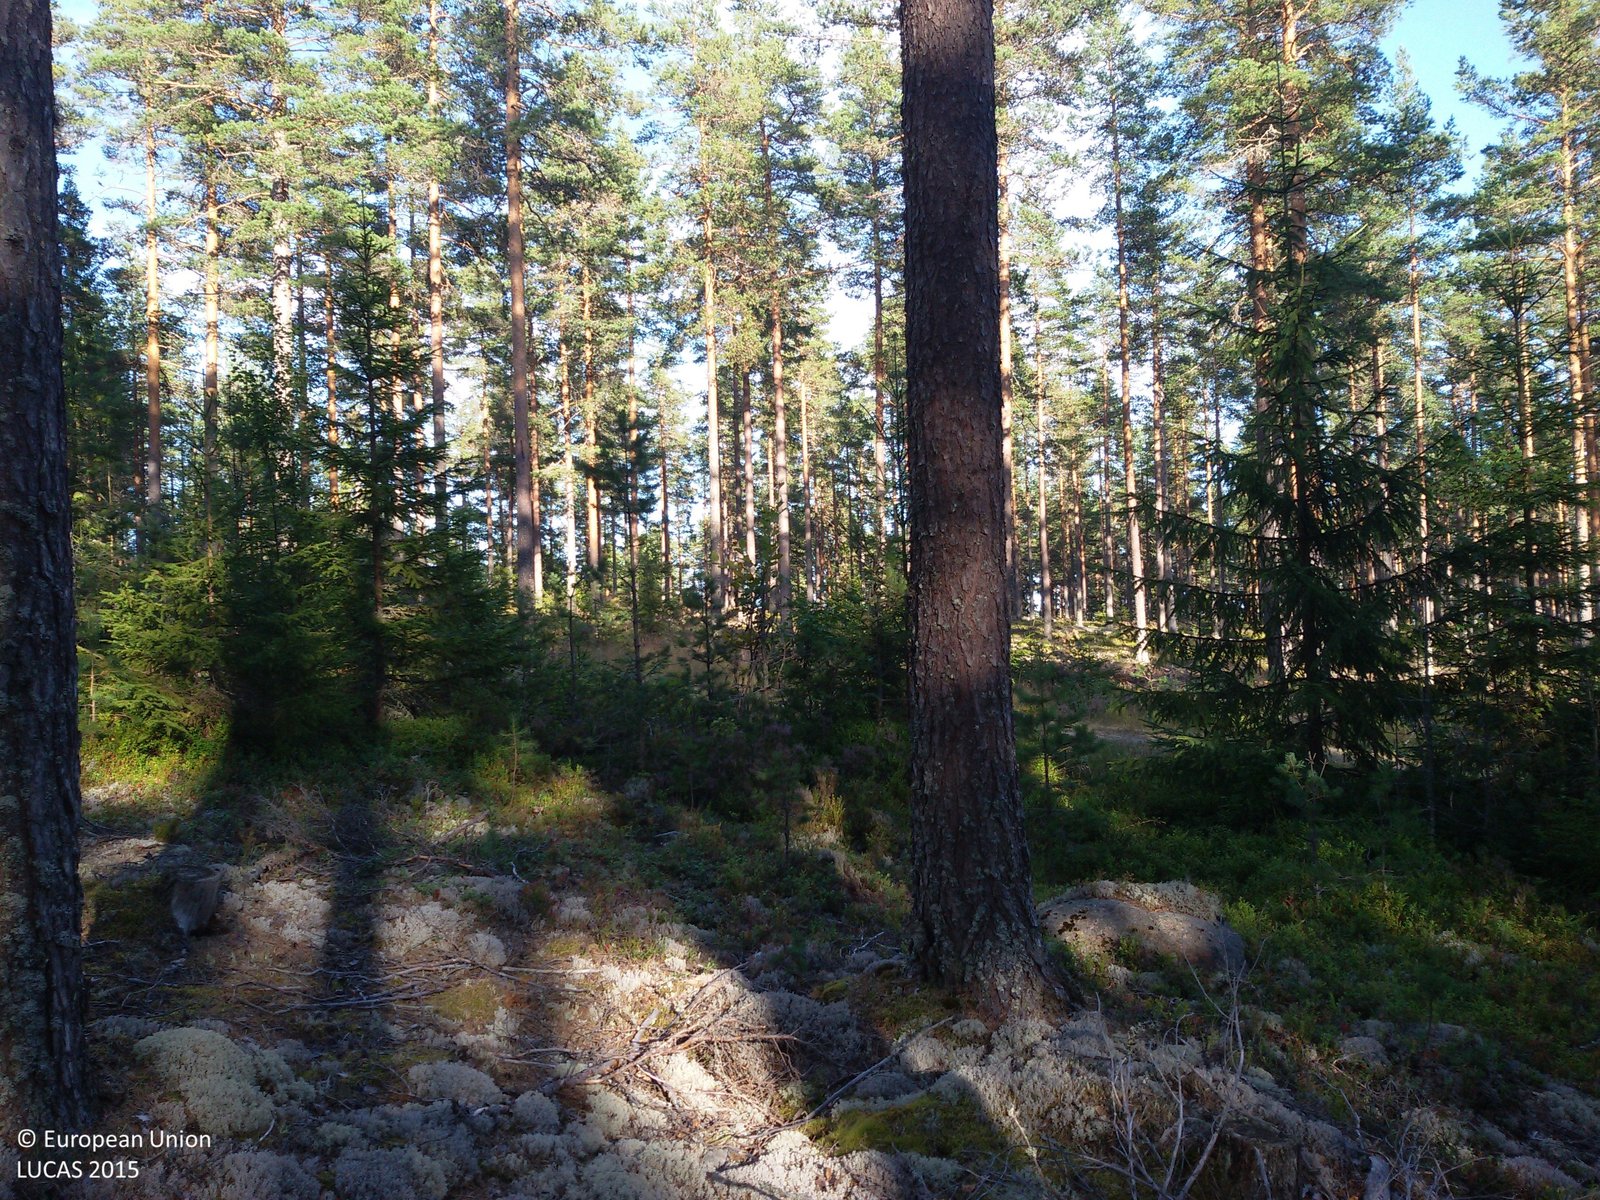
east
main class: Woodland
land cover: Pine dominated coniferous woodland
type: boreal forest
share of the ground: > 75 %
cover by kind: coniferous forest trees 80 %, lichens and mosses 20 %
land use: Forestry
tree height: > 5 m
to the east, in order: Pine dominated coniferous woodland; Paved roads, cycling and walking lanes; Pine dominated coniferous woodland
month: August
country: SE
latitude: 60.8312
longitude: 15.9645
